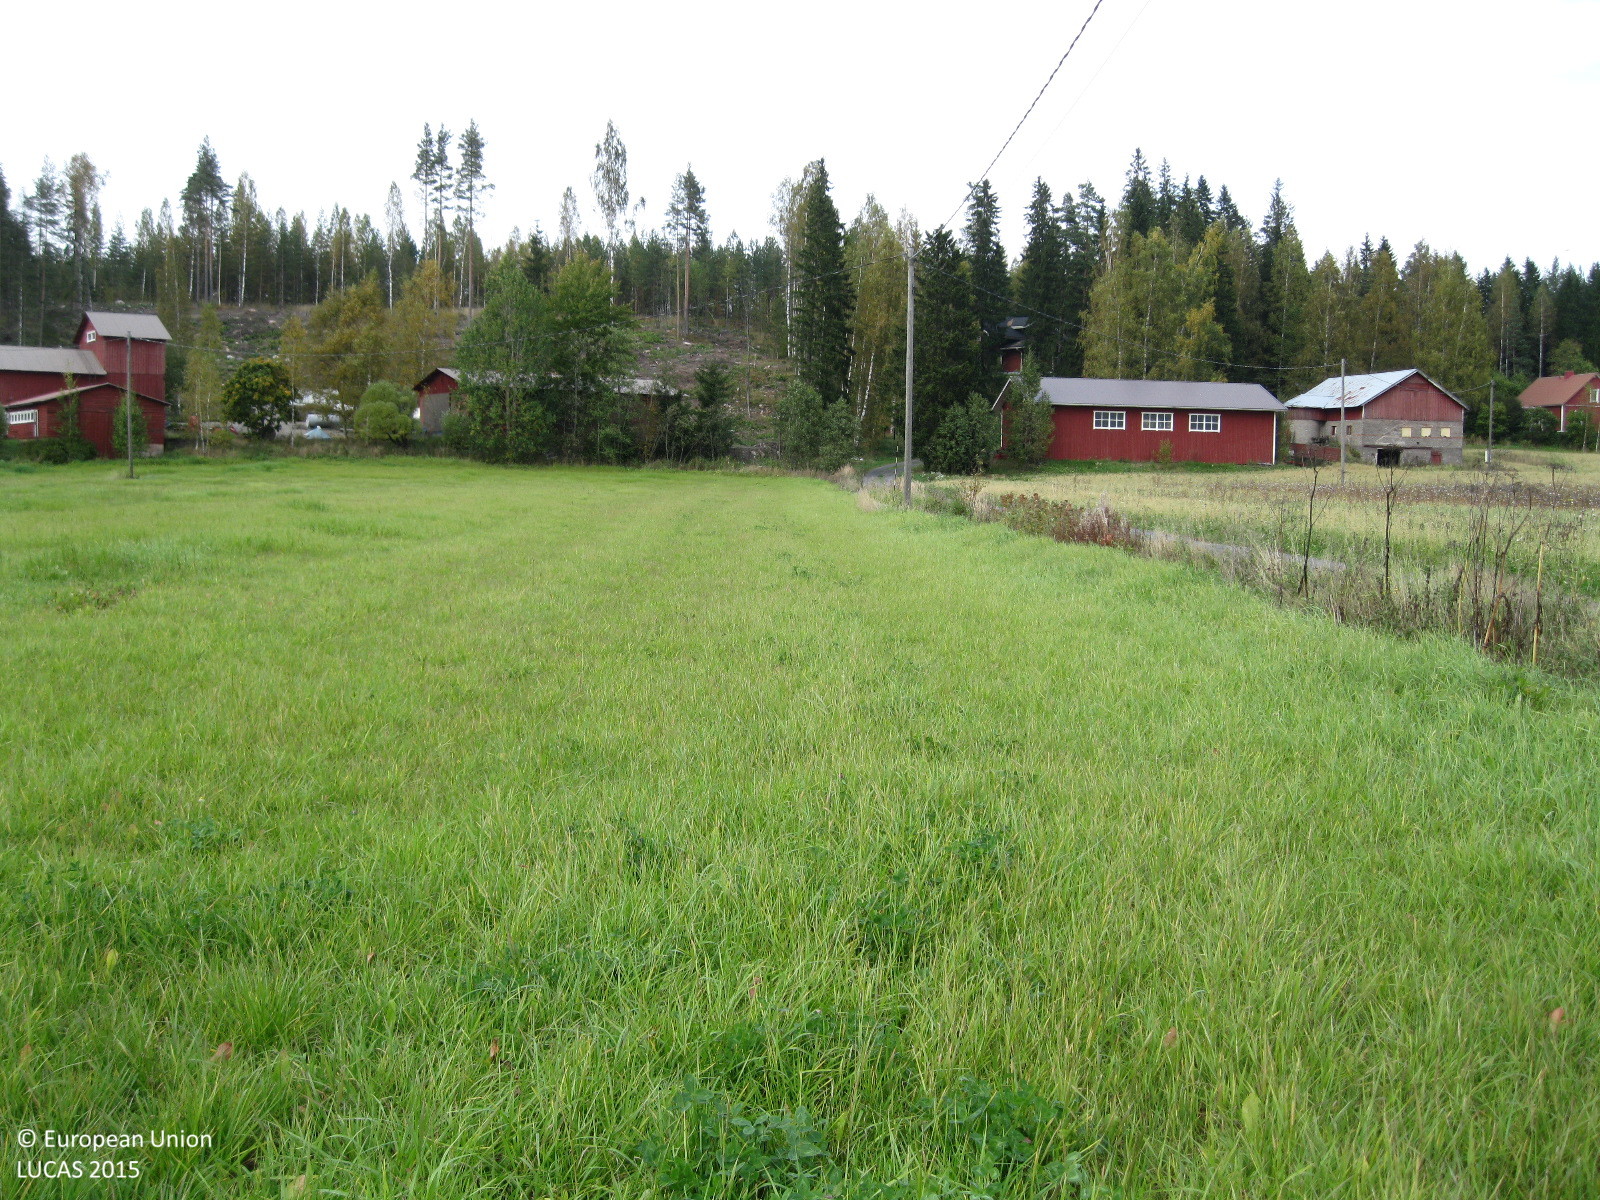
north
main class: Cropland
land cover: Temporary grasslands
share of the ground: > 75 %
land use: Agriculture (excluding fallow land and kitchen gardens)
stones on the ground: < 10 %
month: September
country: FI
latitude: 60.5842
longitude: 24.6566
